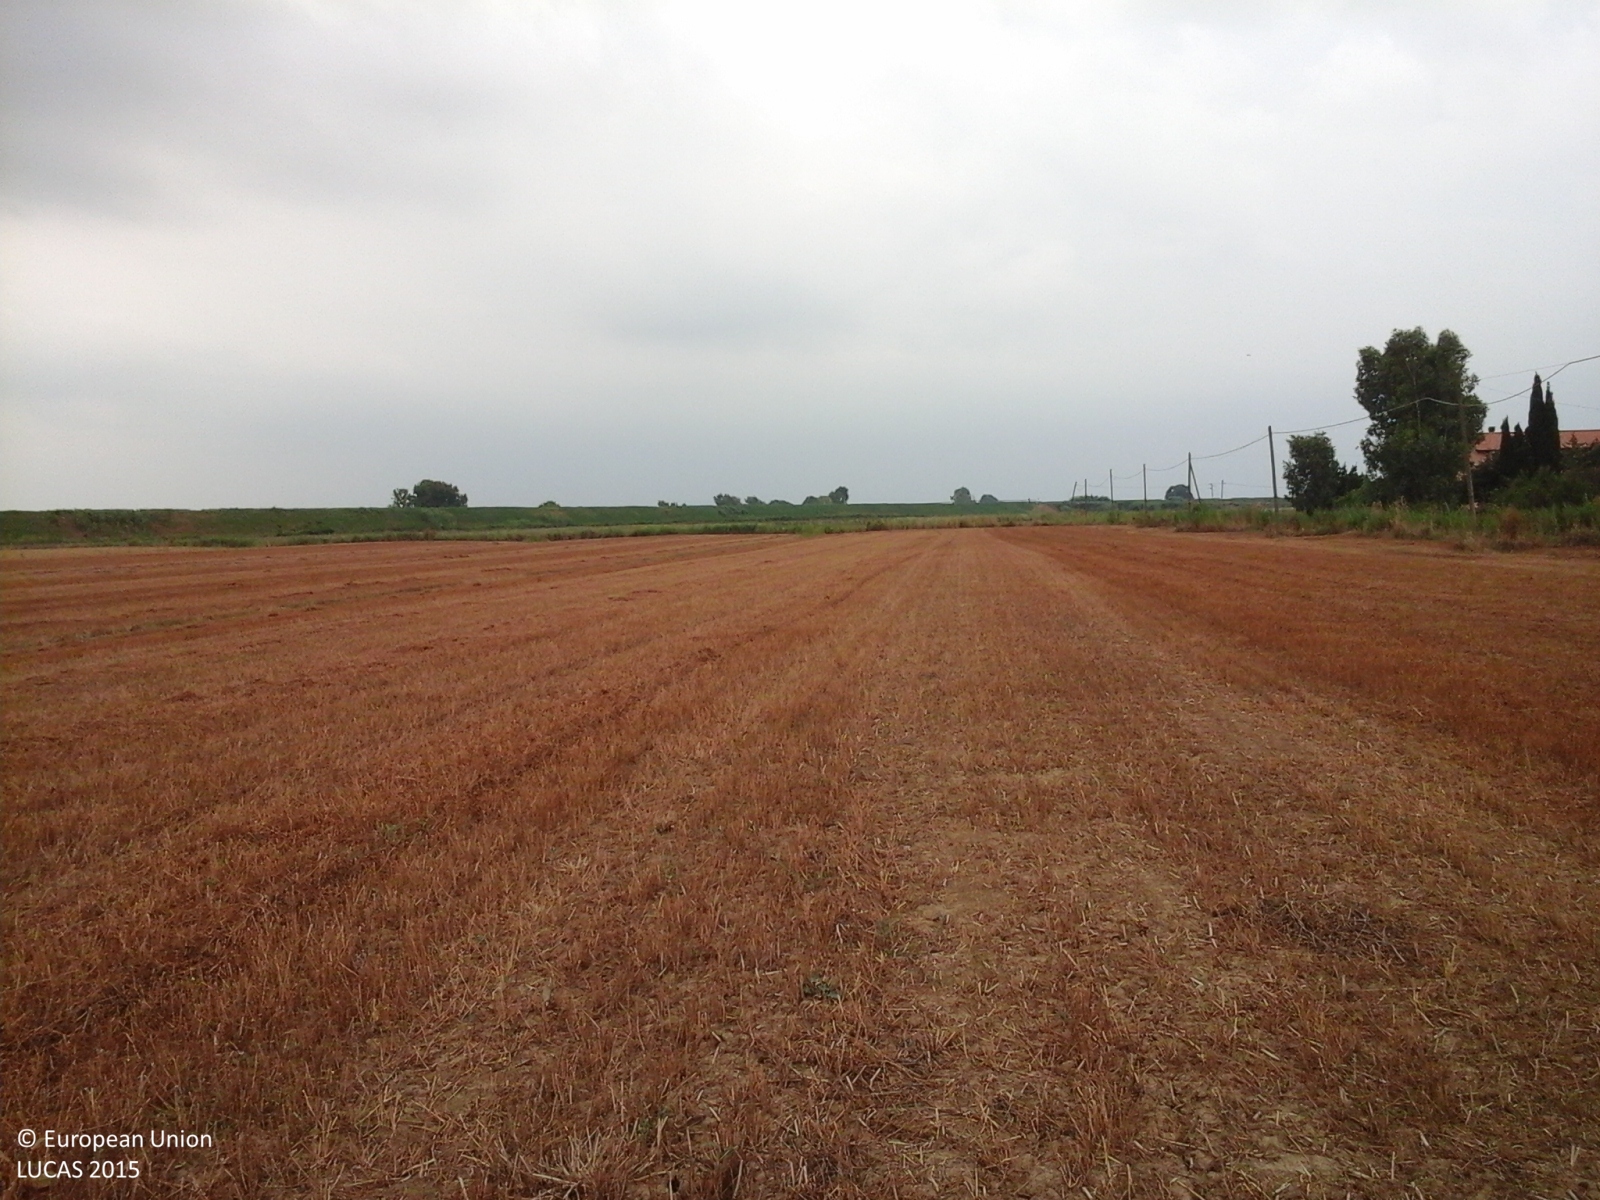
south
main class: Cropland
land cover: Clovers
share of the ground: > 75 %
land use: Agriculture (excluding fallow land and kitchen gardens)
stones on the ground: < 10 %
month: August
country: IT
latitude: 42.8474
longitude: 11.0367
